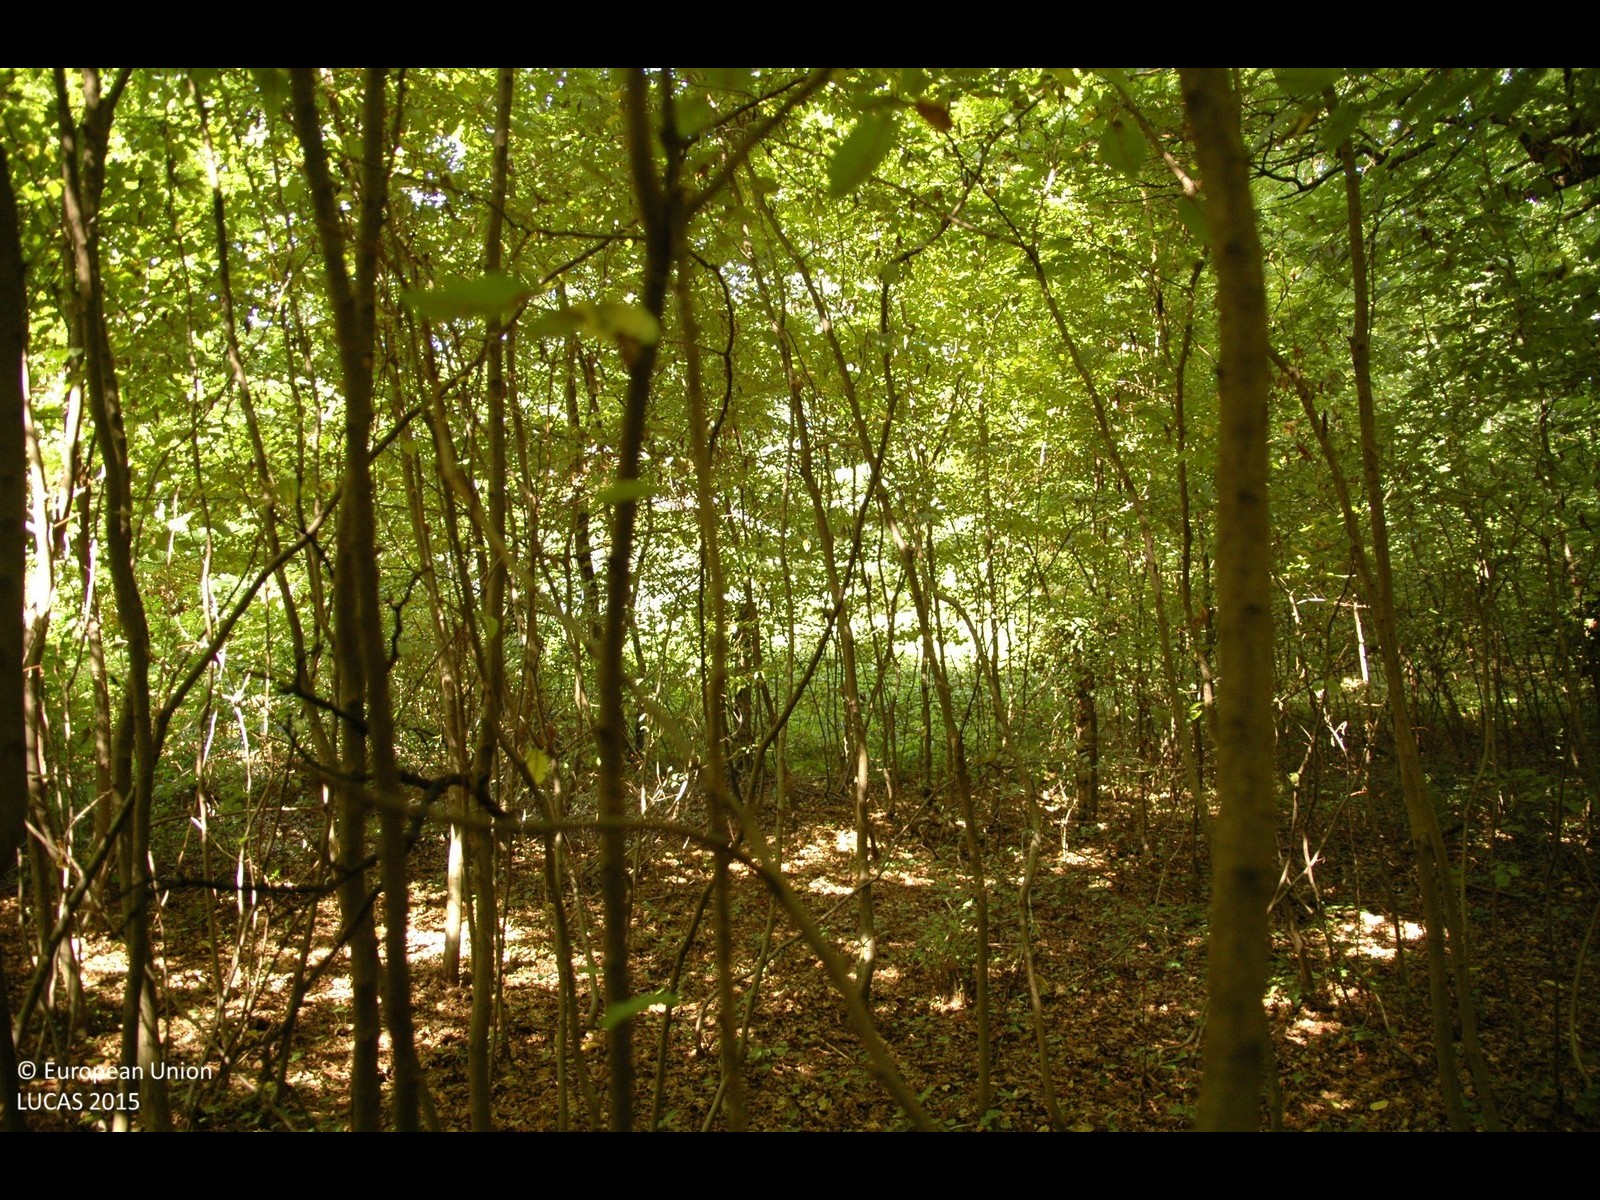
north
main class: Woodland
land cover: Broadleaved woodland
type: mesophytic deciduous forest
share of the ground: > 75 %
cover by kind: broadleaved forest trees 100 %
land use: Semi-natural and natural areas not in use
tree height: > 5 m
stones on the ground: < 10 %
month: August
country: HR
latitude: 46.1529
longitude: 16.7989
